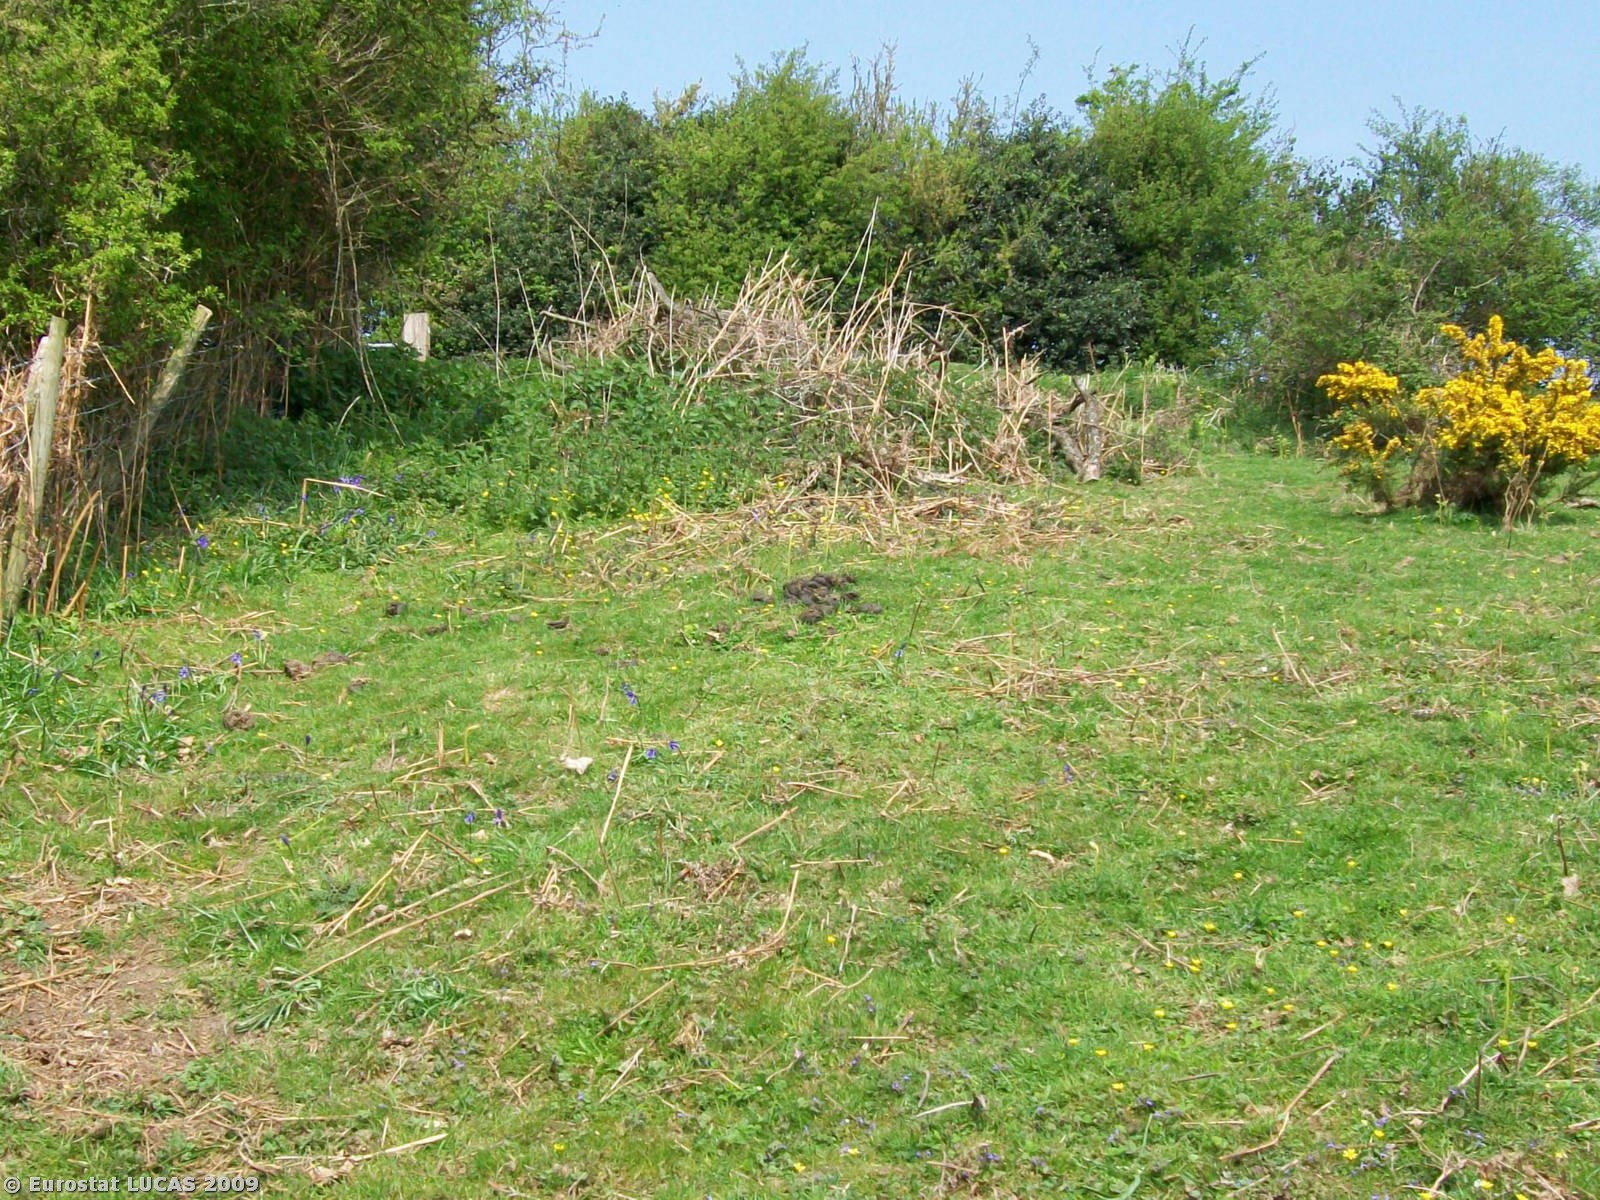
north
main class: Grassland
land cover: Grassland with sparse tree/shrub cover
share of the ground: > 75 %
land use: Agriculture (excluding fallow land and kitchen gardens)
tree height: < 5 m
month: April
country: GB
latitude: 50.8633
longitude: 0.3808
